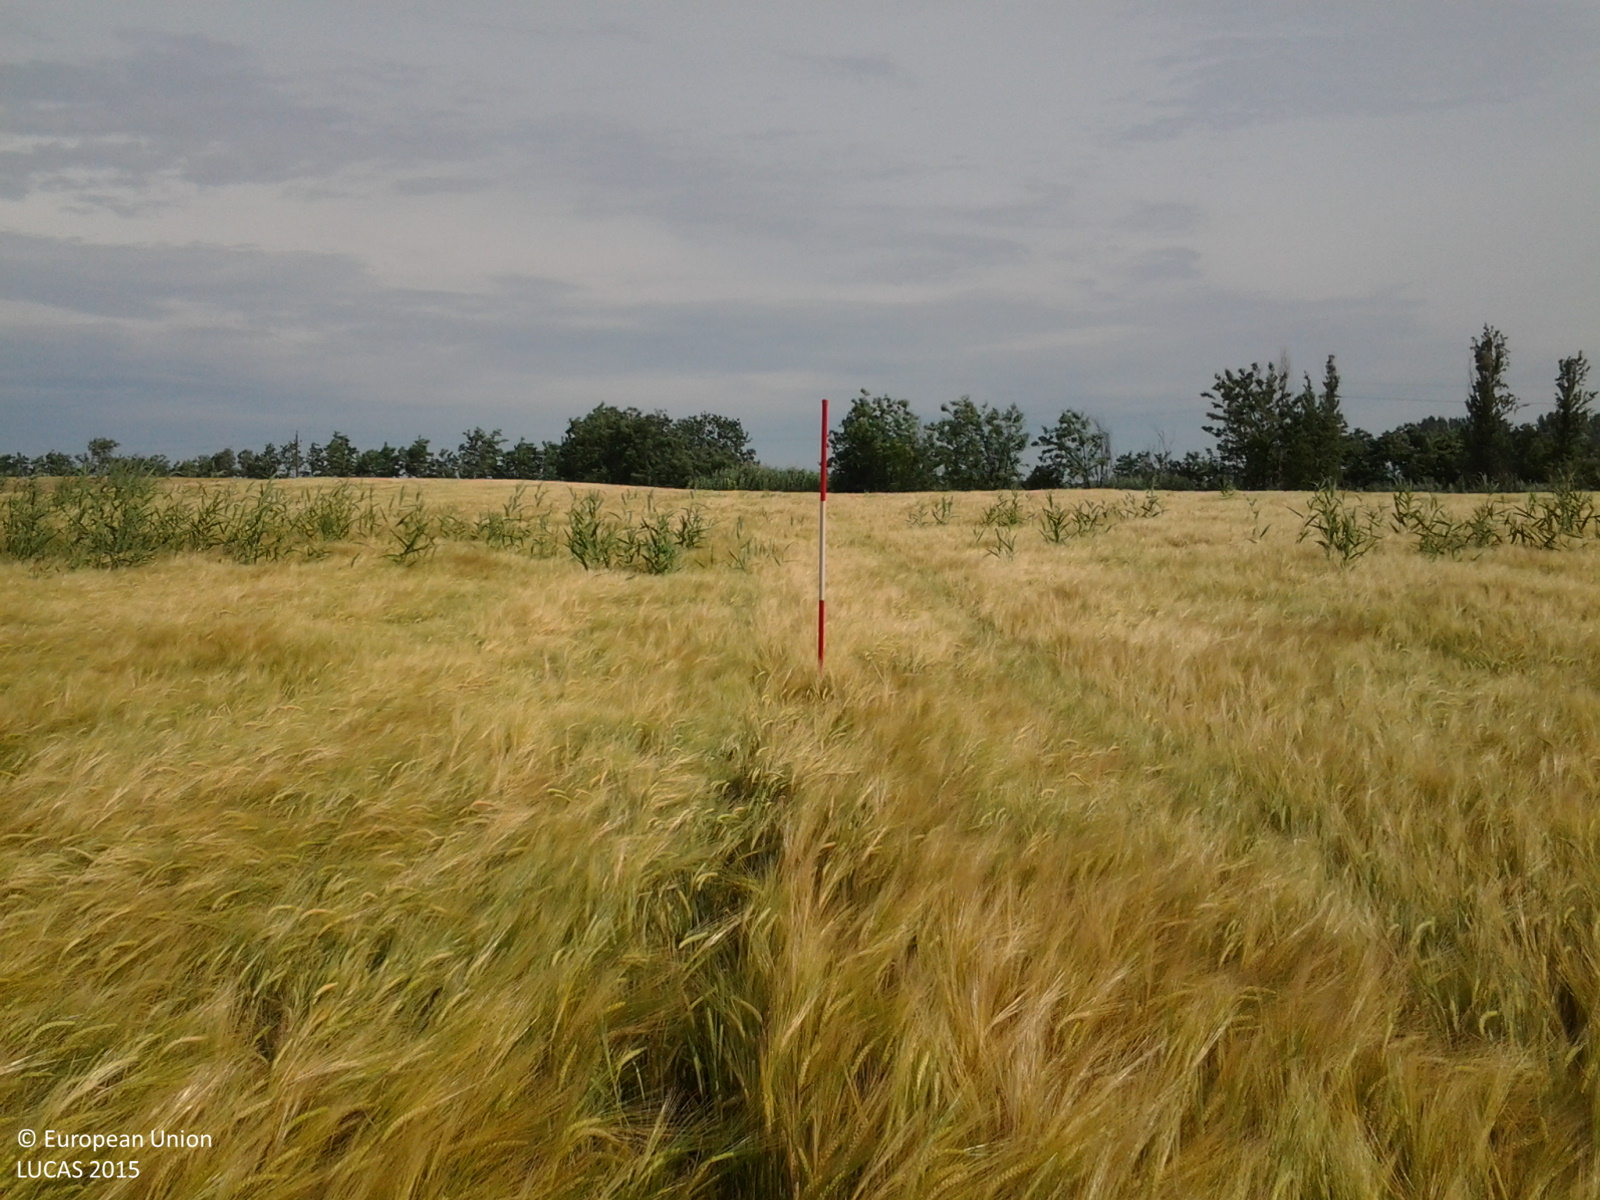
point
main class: Cropland
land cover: Barley
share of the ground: > 75 %
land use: Agriculture (excluding fallow land and kitchen gardens)
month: June
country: HU
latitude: 46.4731
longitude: 21.1691
